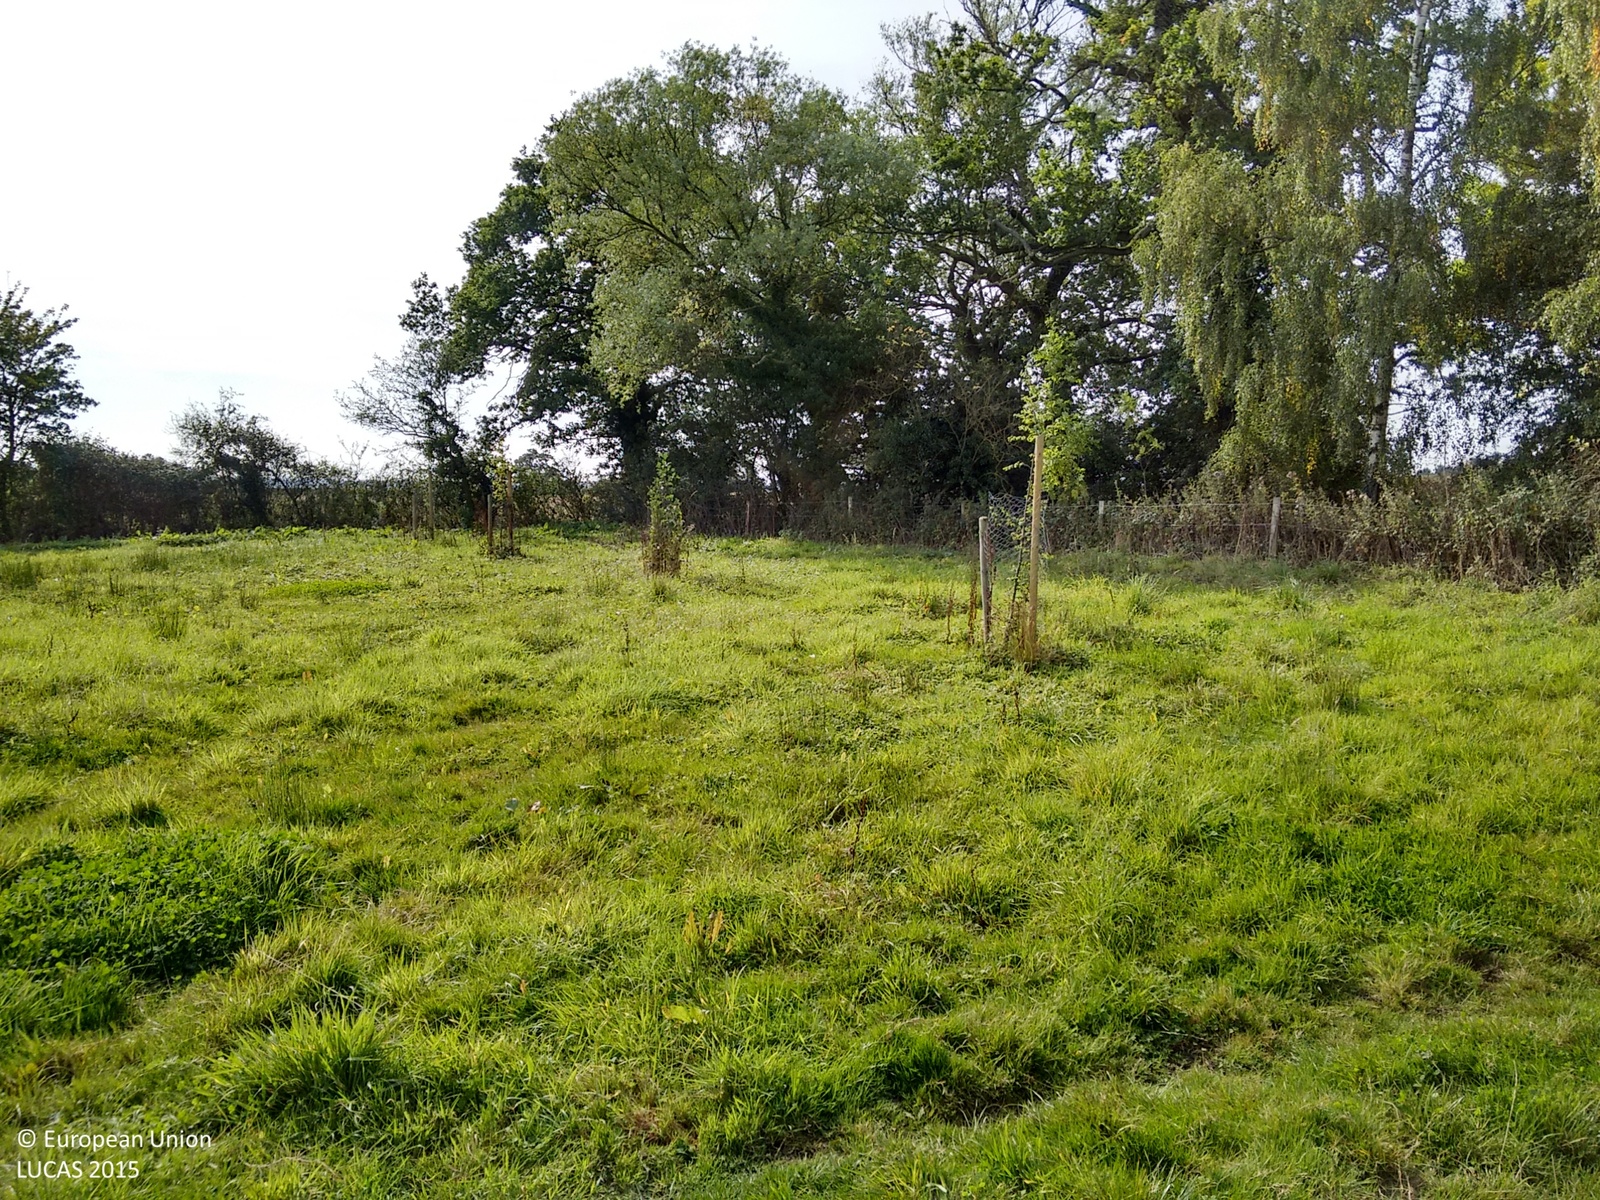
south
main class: Grassland
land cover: Grassland without tree/shrub cover
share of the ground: > 75 %
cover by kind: herbaceous plants 100 %
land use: Agriculture (excluding fallow land and kitchen gardens)
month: September
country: GB
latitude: 51.6521
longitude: -2.3938
